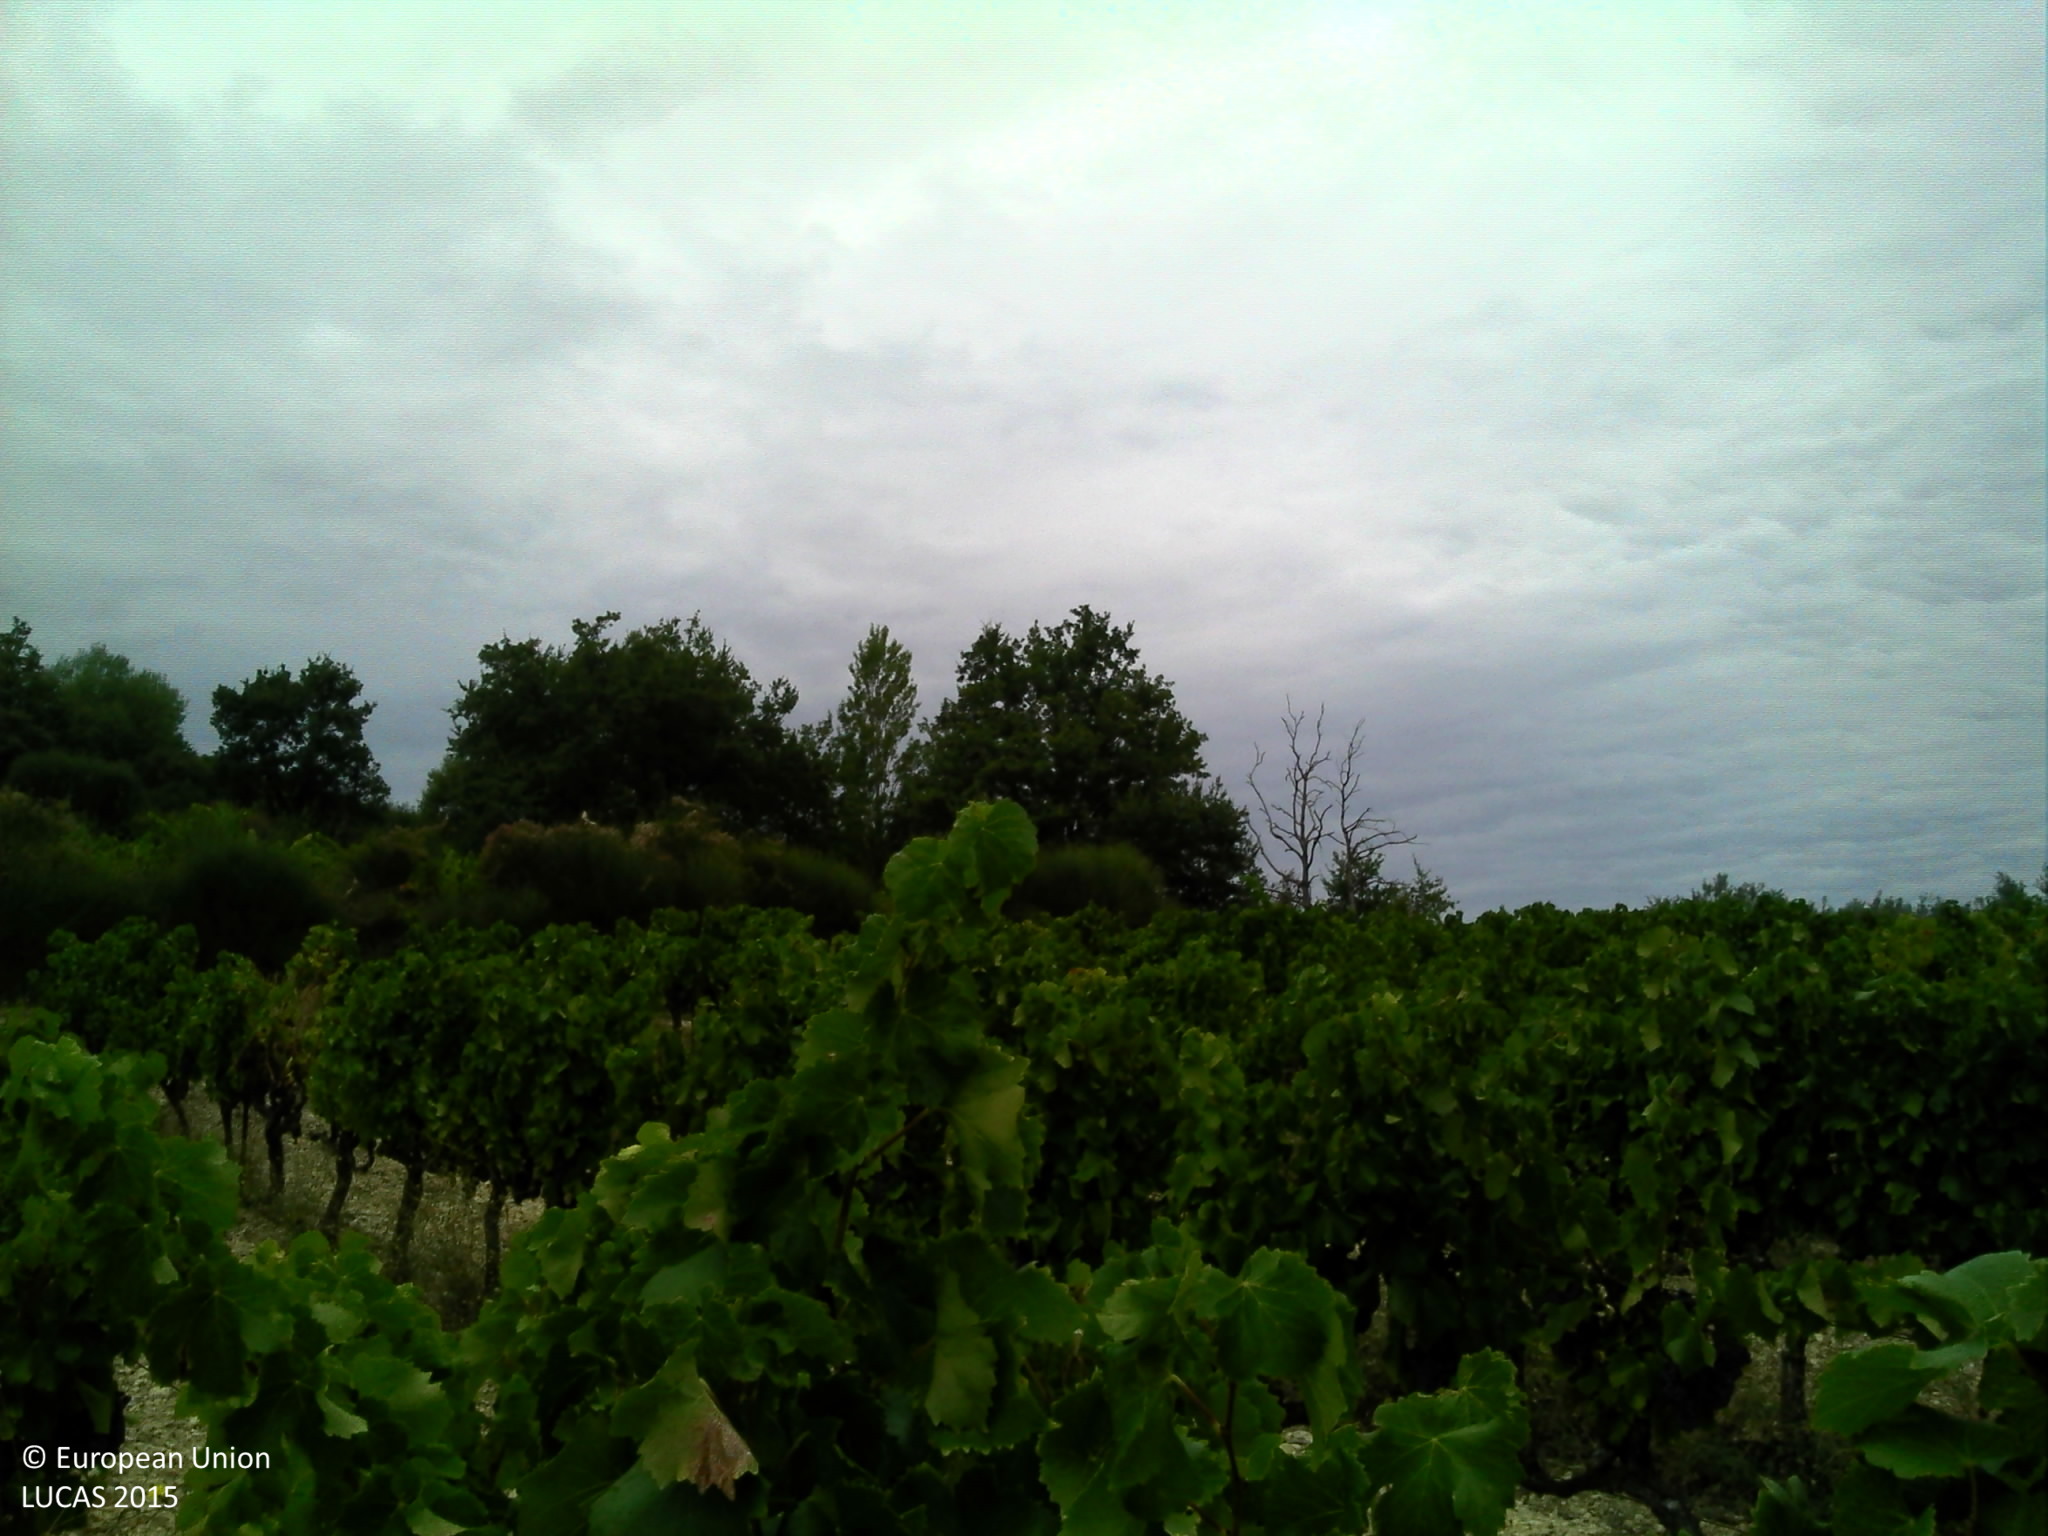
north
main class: Cropland
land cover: Vineyards
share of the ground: 50 - 75 %
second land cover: Grassland without tree/shrub cover
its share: 10 - 25 %
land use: Agriculture (excluding fallow land and kitchen gardens)
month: September
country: FR
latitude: 44.3422
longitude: 5.0780
